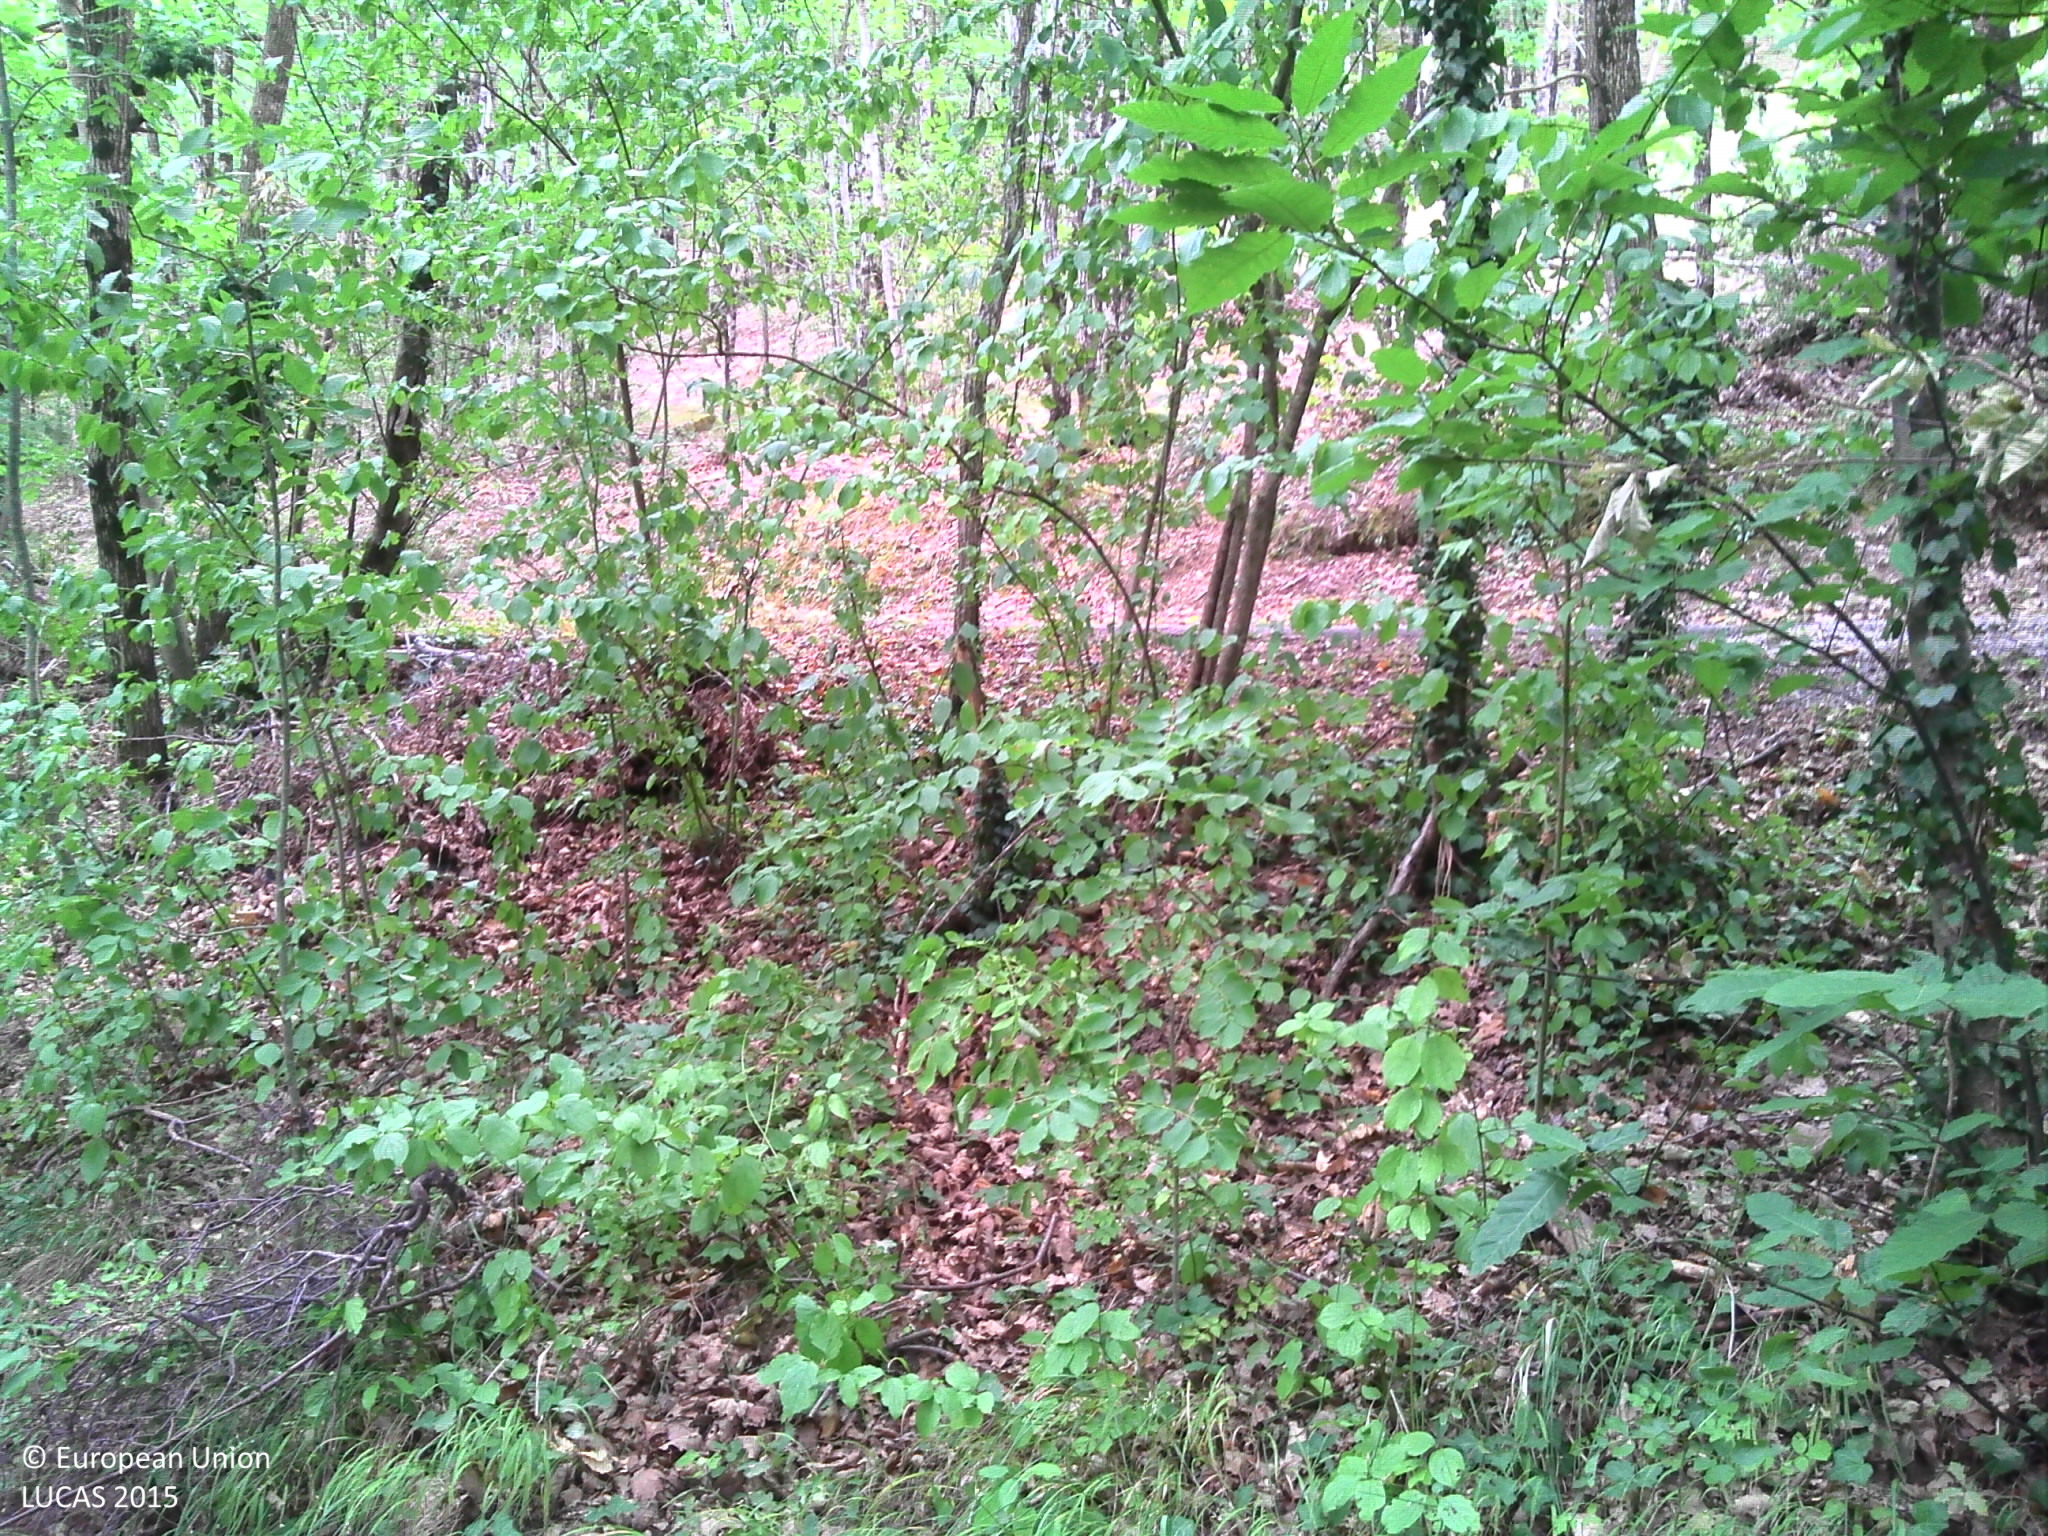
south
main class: Woodland
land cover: Broadleaved woodland
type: broadleaved evergreen forest
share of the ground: > 75 %
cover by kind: broadleaved forest trees 100 %
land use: Semi-natural and natural areas not in use
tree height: > 5 m
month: July
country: FR
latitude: 44.7527
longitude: 4.6123
